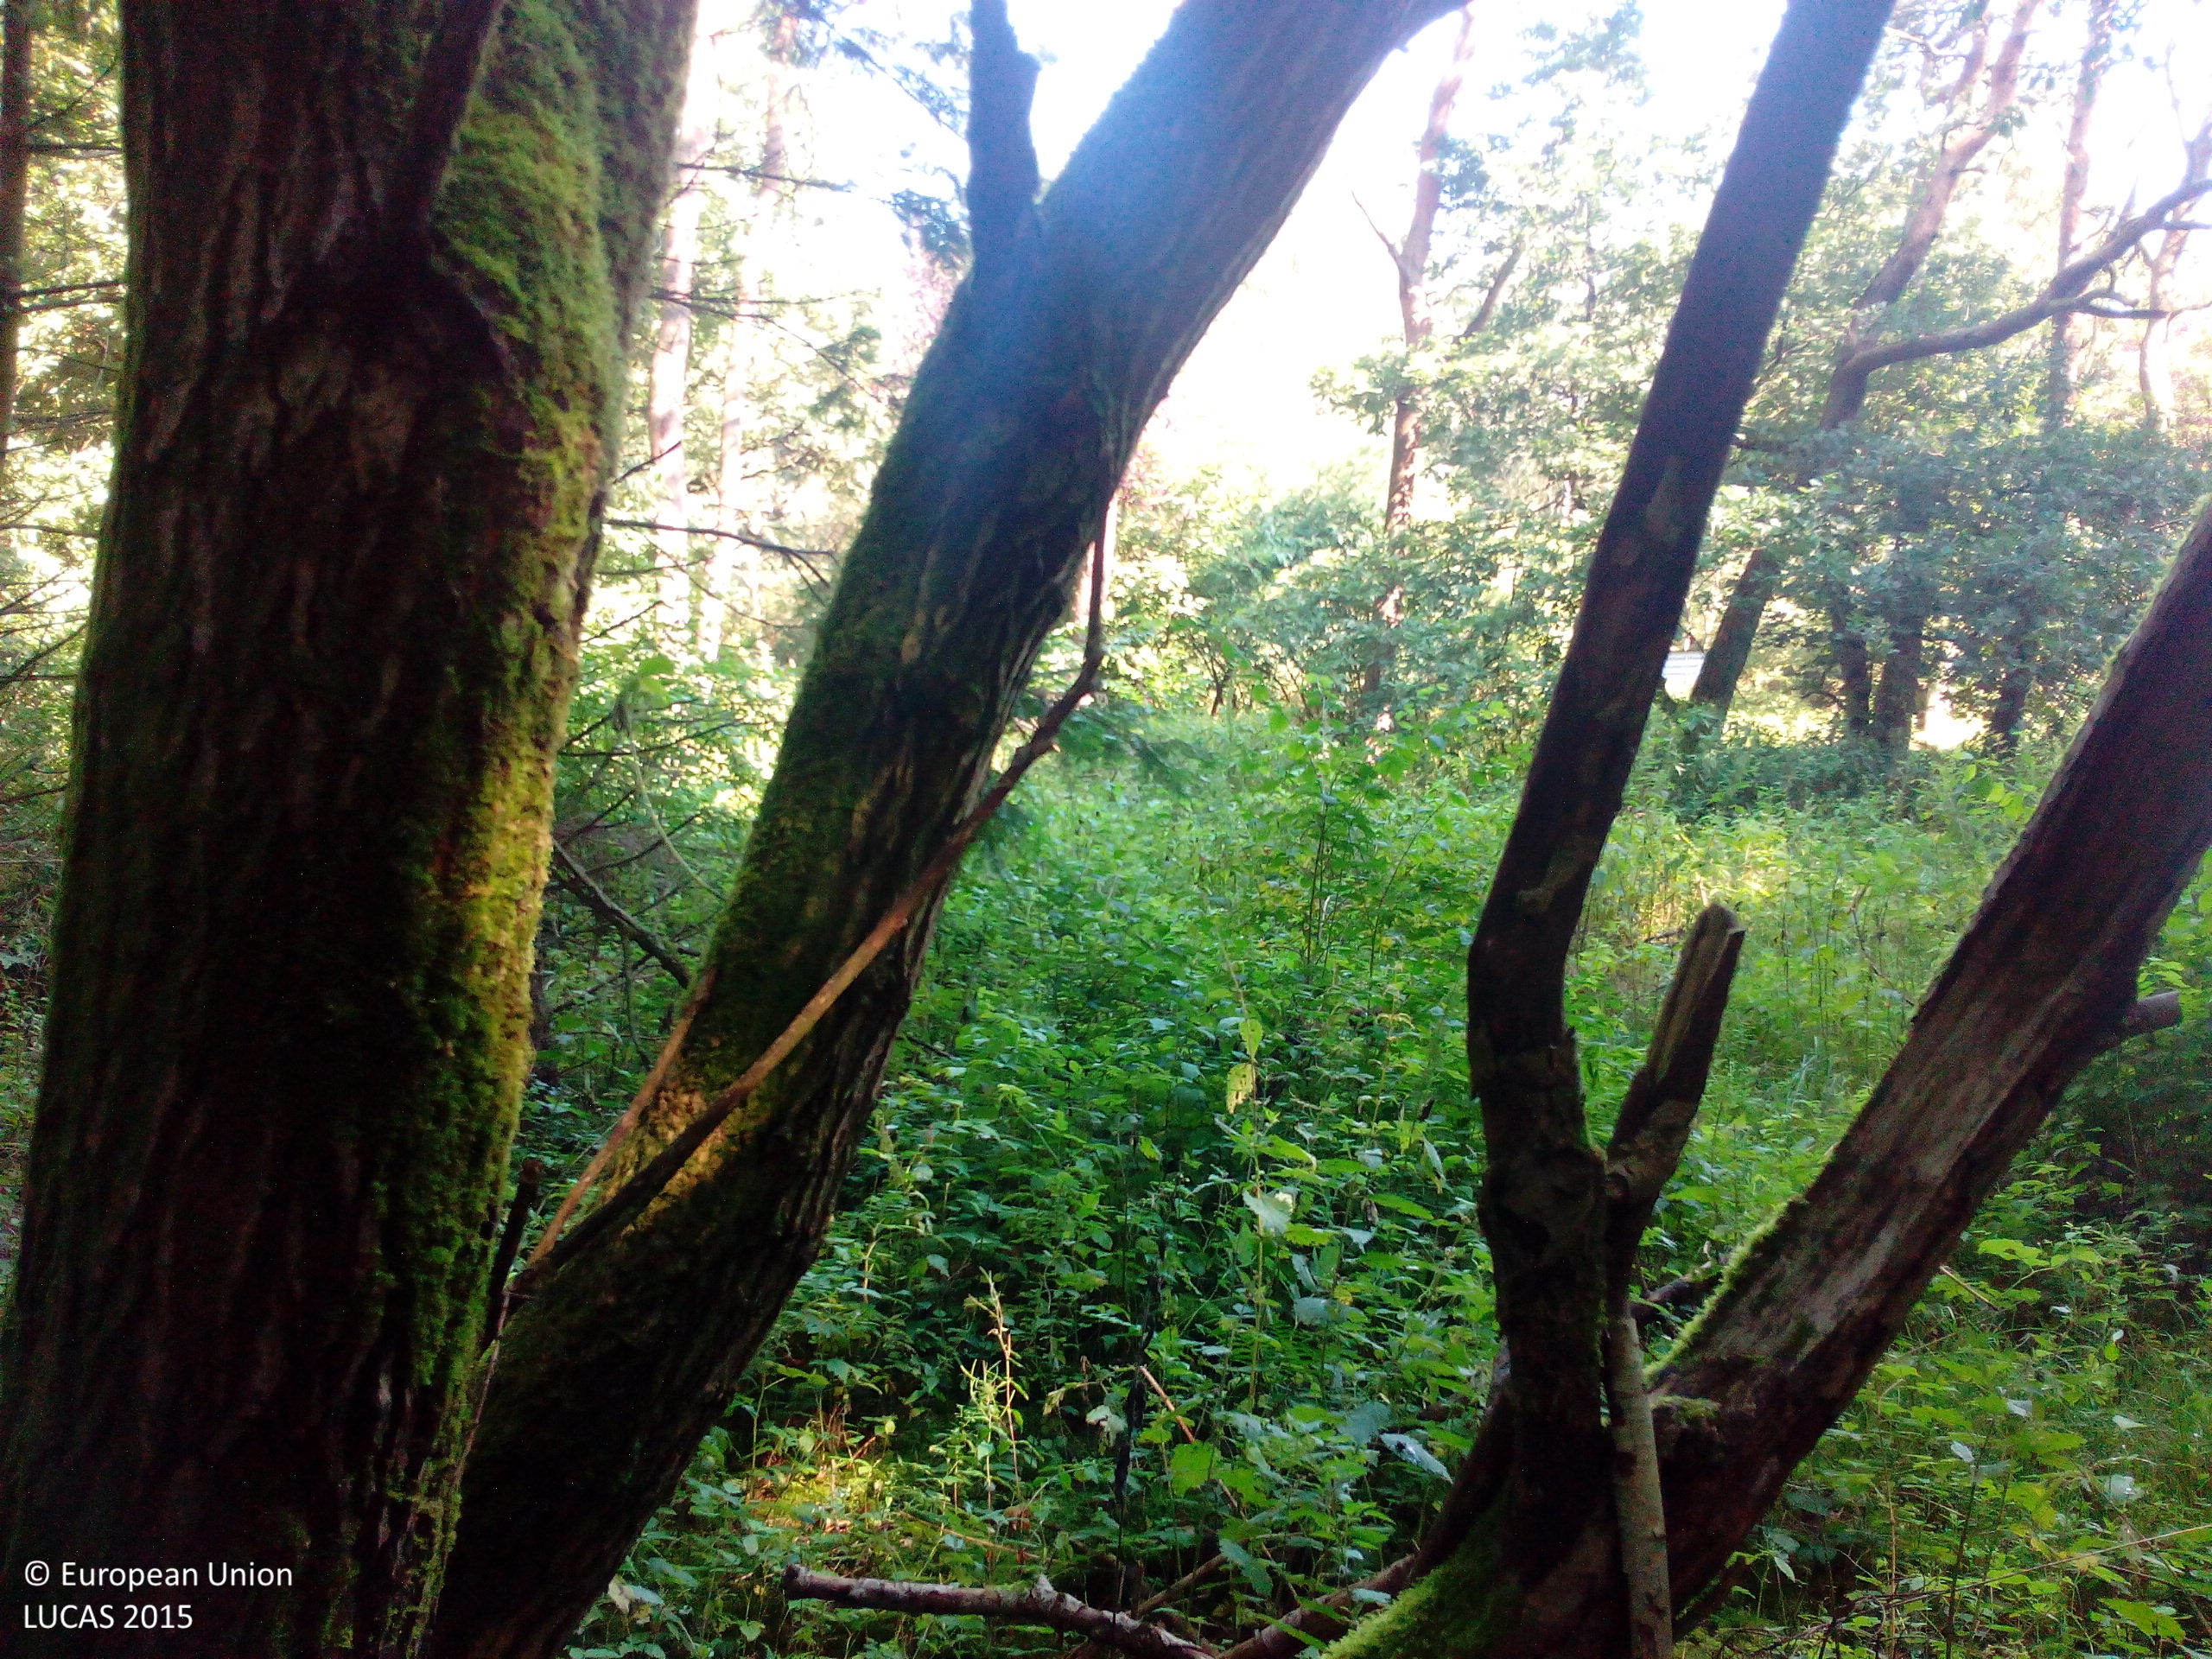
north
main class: Woodland
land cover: Other mixed woodland
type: hemiboreal forest and nemoral coniferous forest and mixed broadleaved-coniferous forest
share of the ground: > 75 %
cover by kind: coniferous forest trees 75 %, broadleaved forest trees 25 %
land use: Forestry
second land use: Amenities, museums, leisure
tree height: > 5 m
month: August
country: DE
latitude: 53.8152
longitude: 9.8330
